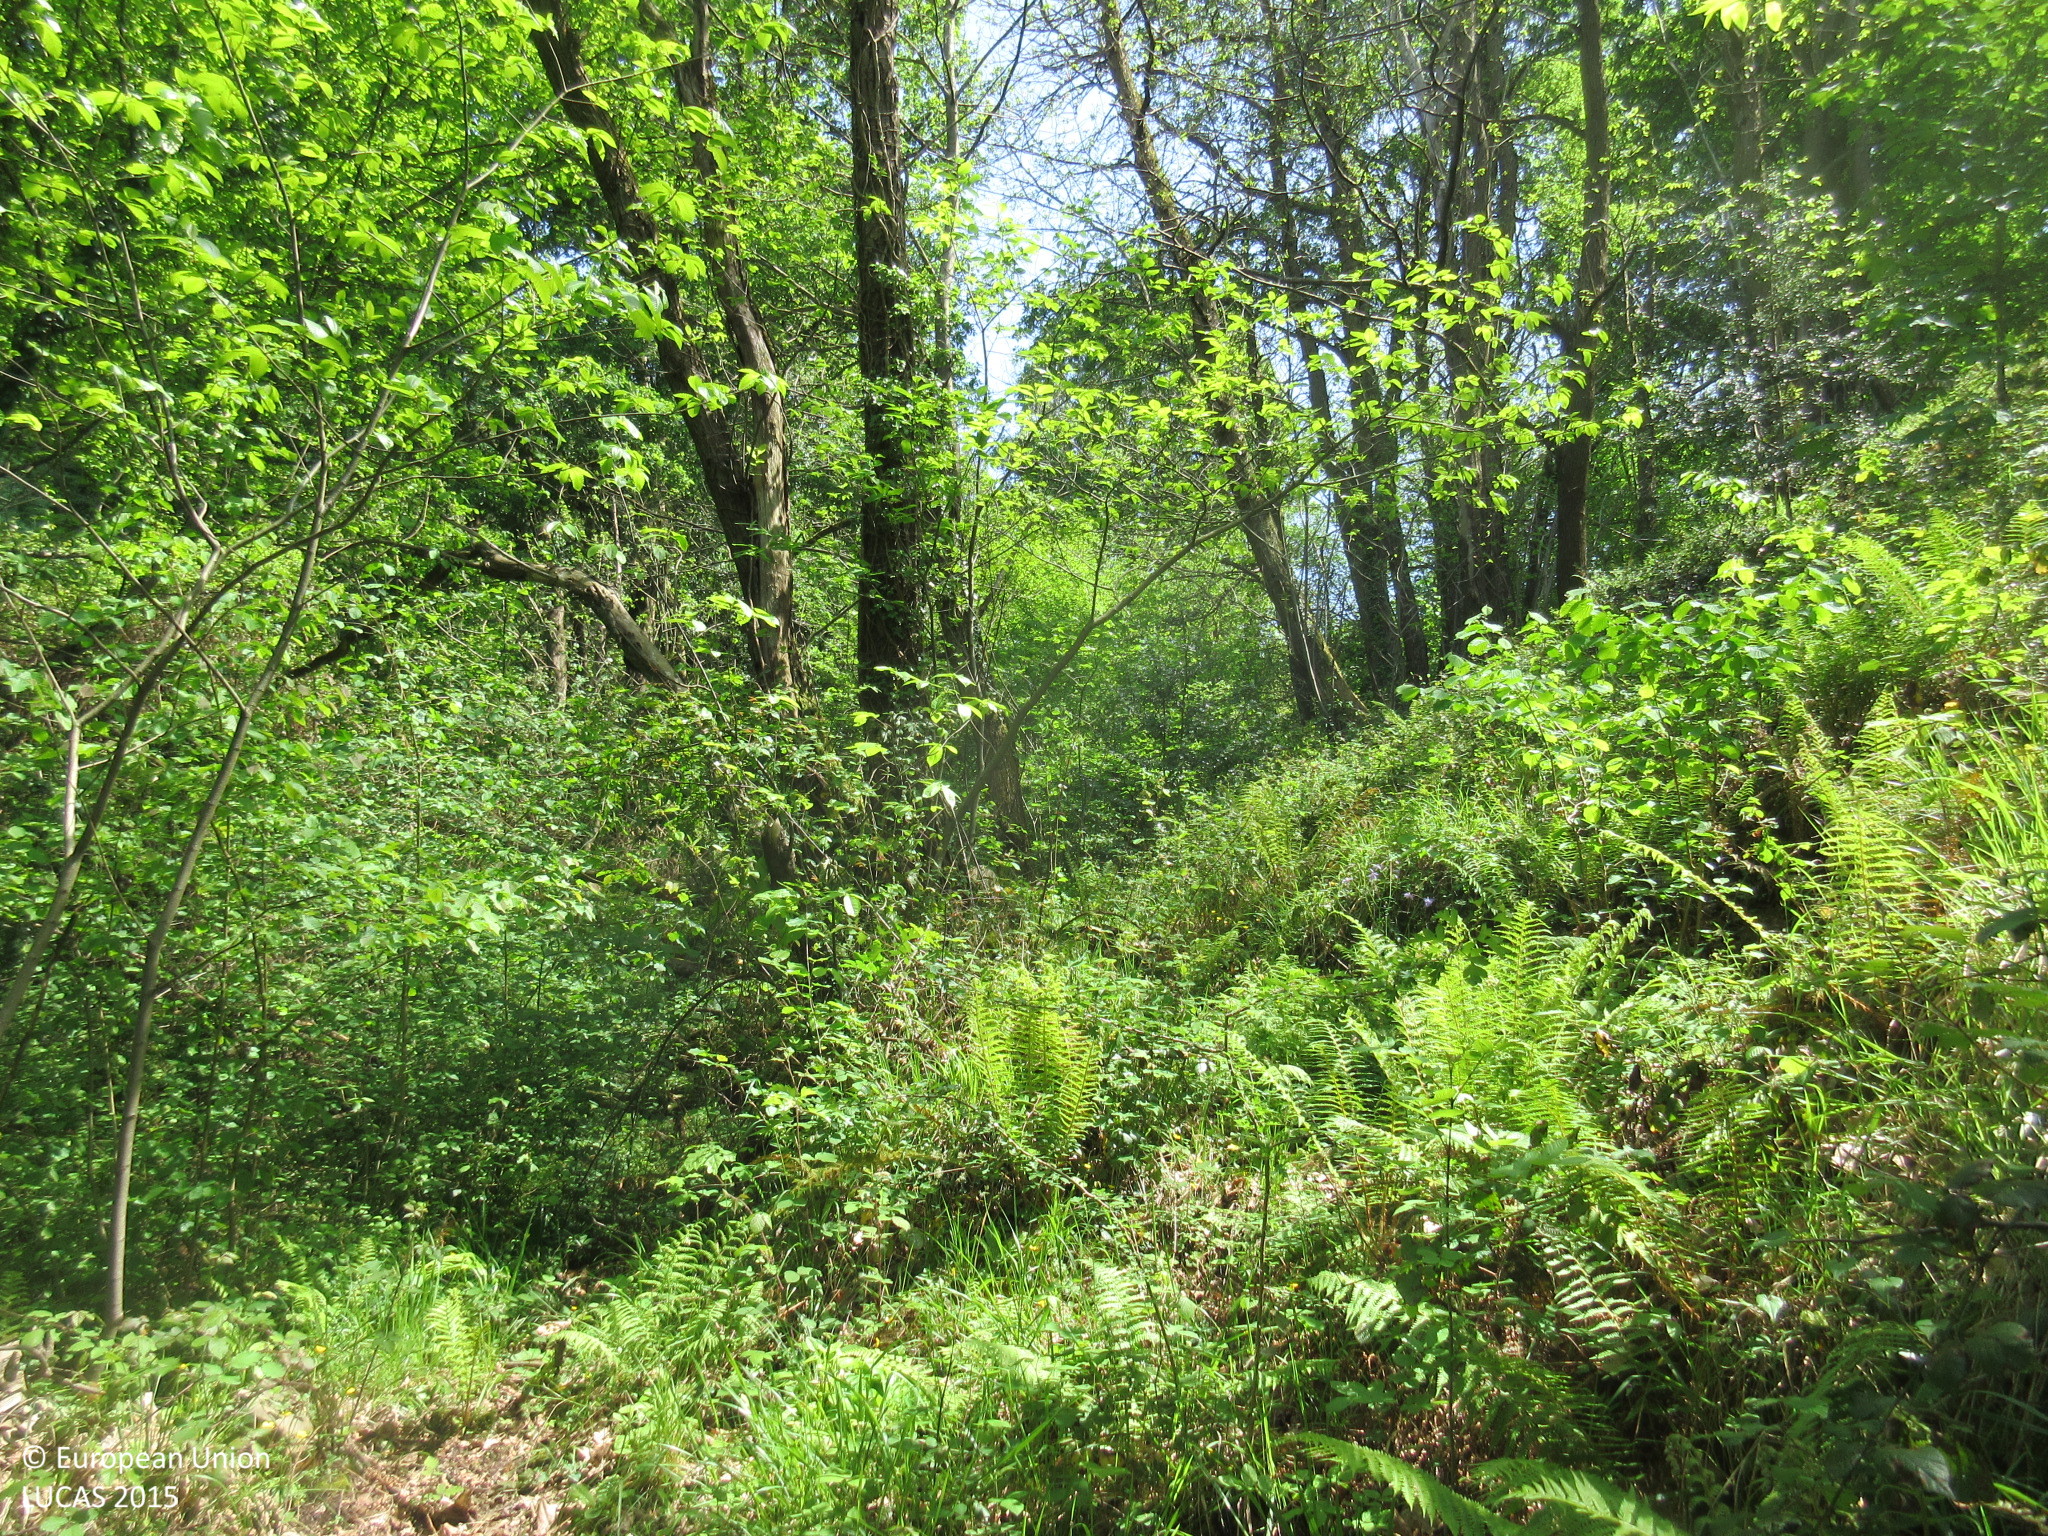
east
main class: Woodland
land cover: Broadleaved woodland
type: thermophilous deciduous forest
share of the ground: > 75 %
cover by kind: broadleaved forest trees 100 %
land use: Semi-natural and natural areas not in use
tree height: > 5 m
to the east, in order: Broadleaved woodland; Grassland without tree/shrub cover; Abandoned hedges; Grassland without tree/shrub cover; Single bushes/trees; Grassland without tree/shrub cover; Abandoned hedges; Grassland without tree/shrub cover
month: May
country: ES
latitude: 43.3058
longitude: -5.8548
